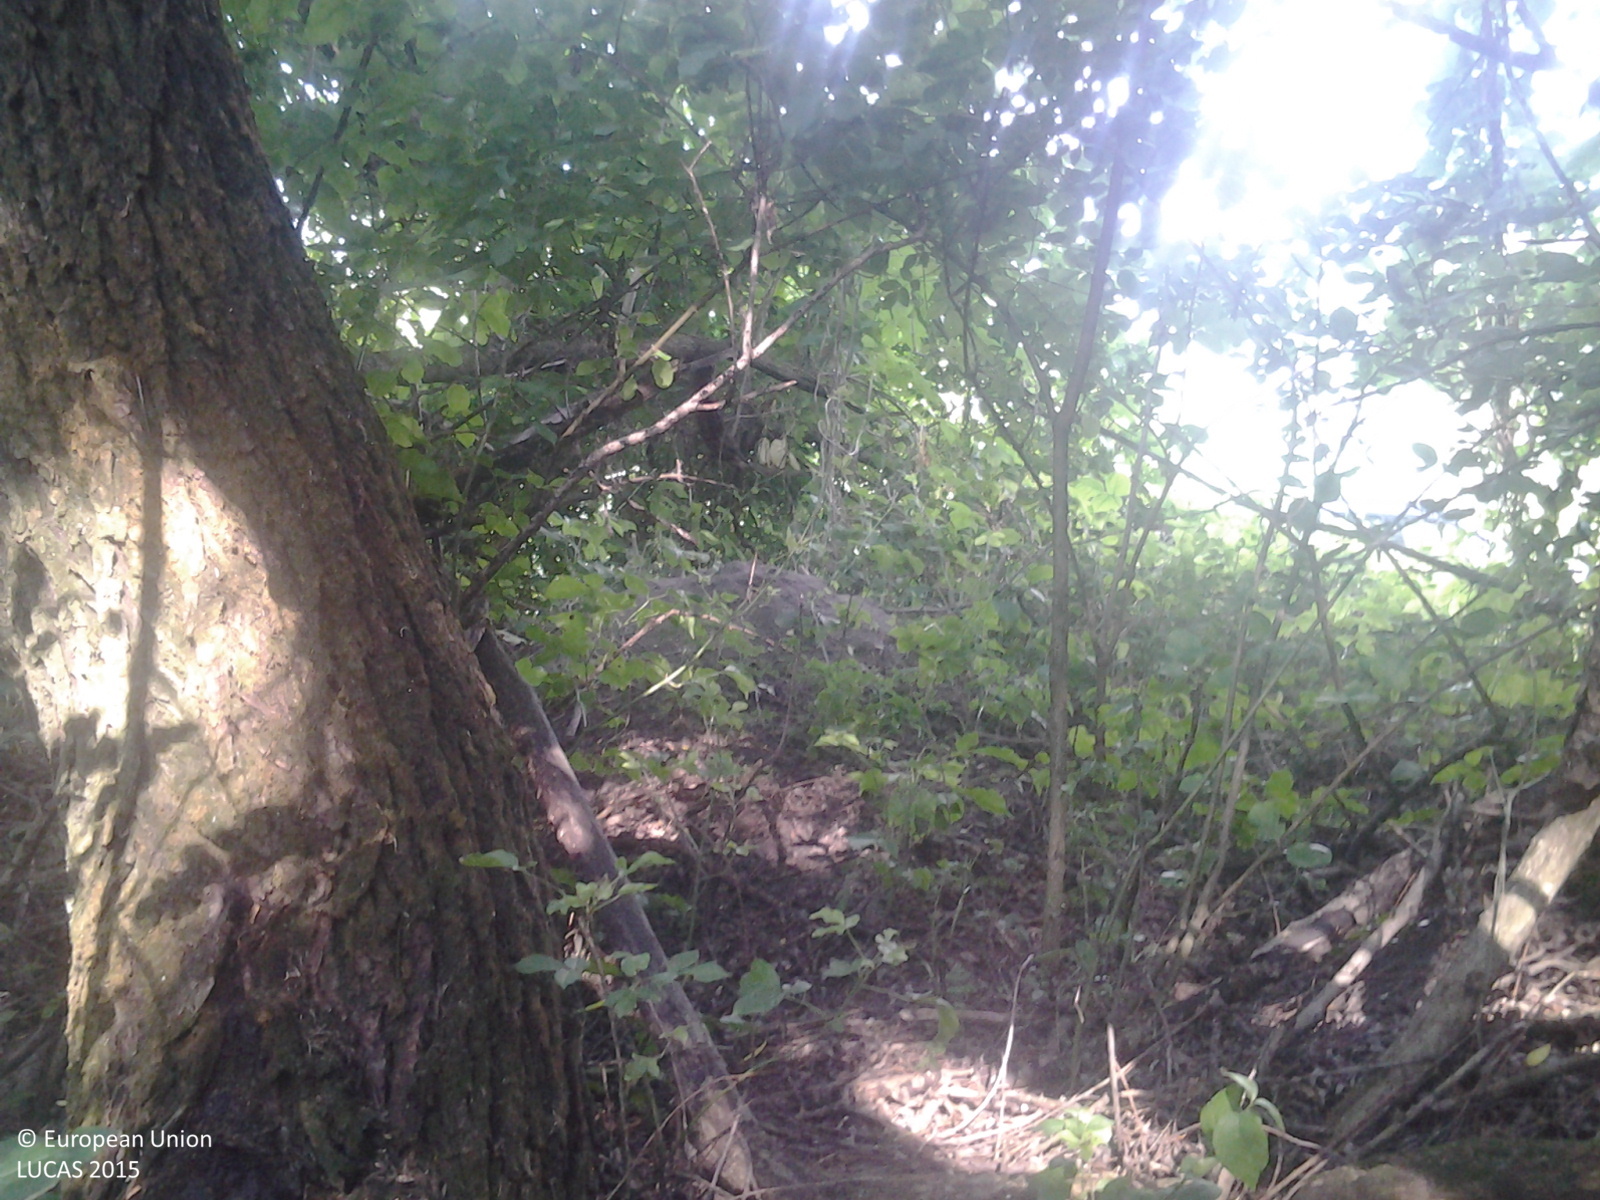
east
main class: Woodland
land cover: Broadleaved woodland
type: mesophytic deciduous forest
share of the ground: > 75 %
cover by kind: broadleaved forest trees 95 %, shrubs 5 %
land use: Forestry
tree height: > 5 m
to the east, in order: Broadleaved woodland; Spontaneously vegetated surfaces; Tracks; Spontaneously vegetated surfaces; Inland fresh running water; Spontaneously vegetated surfaces; Tracks; Grass margins; Maize; Broadleaved woodland
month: June
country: HU
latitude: 46.6069
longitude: 19.1937
